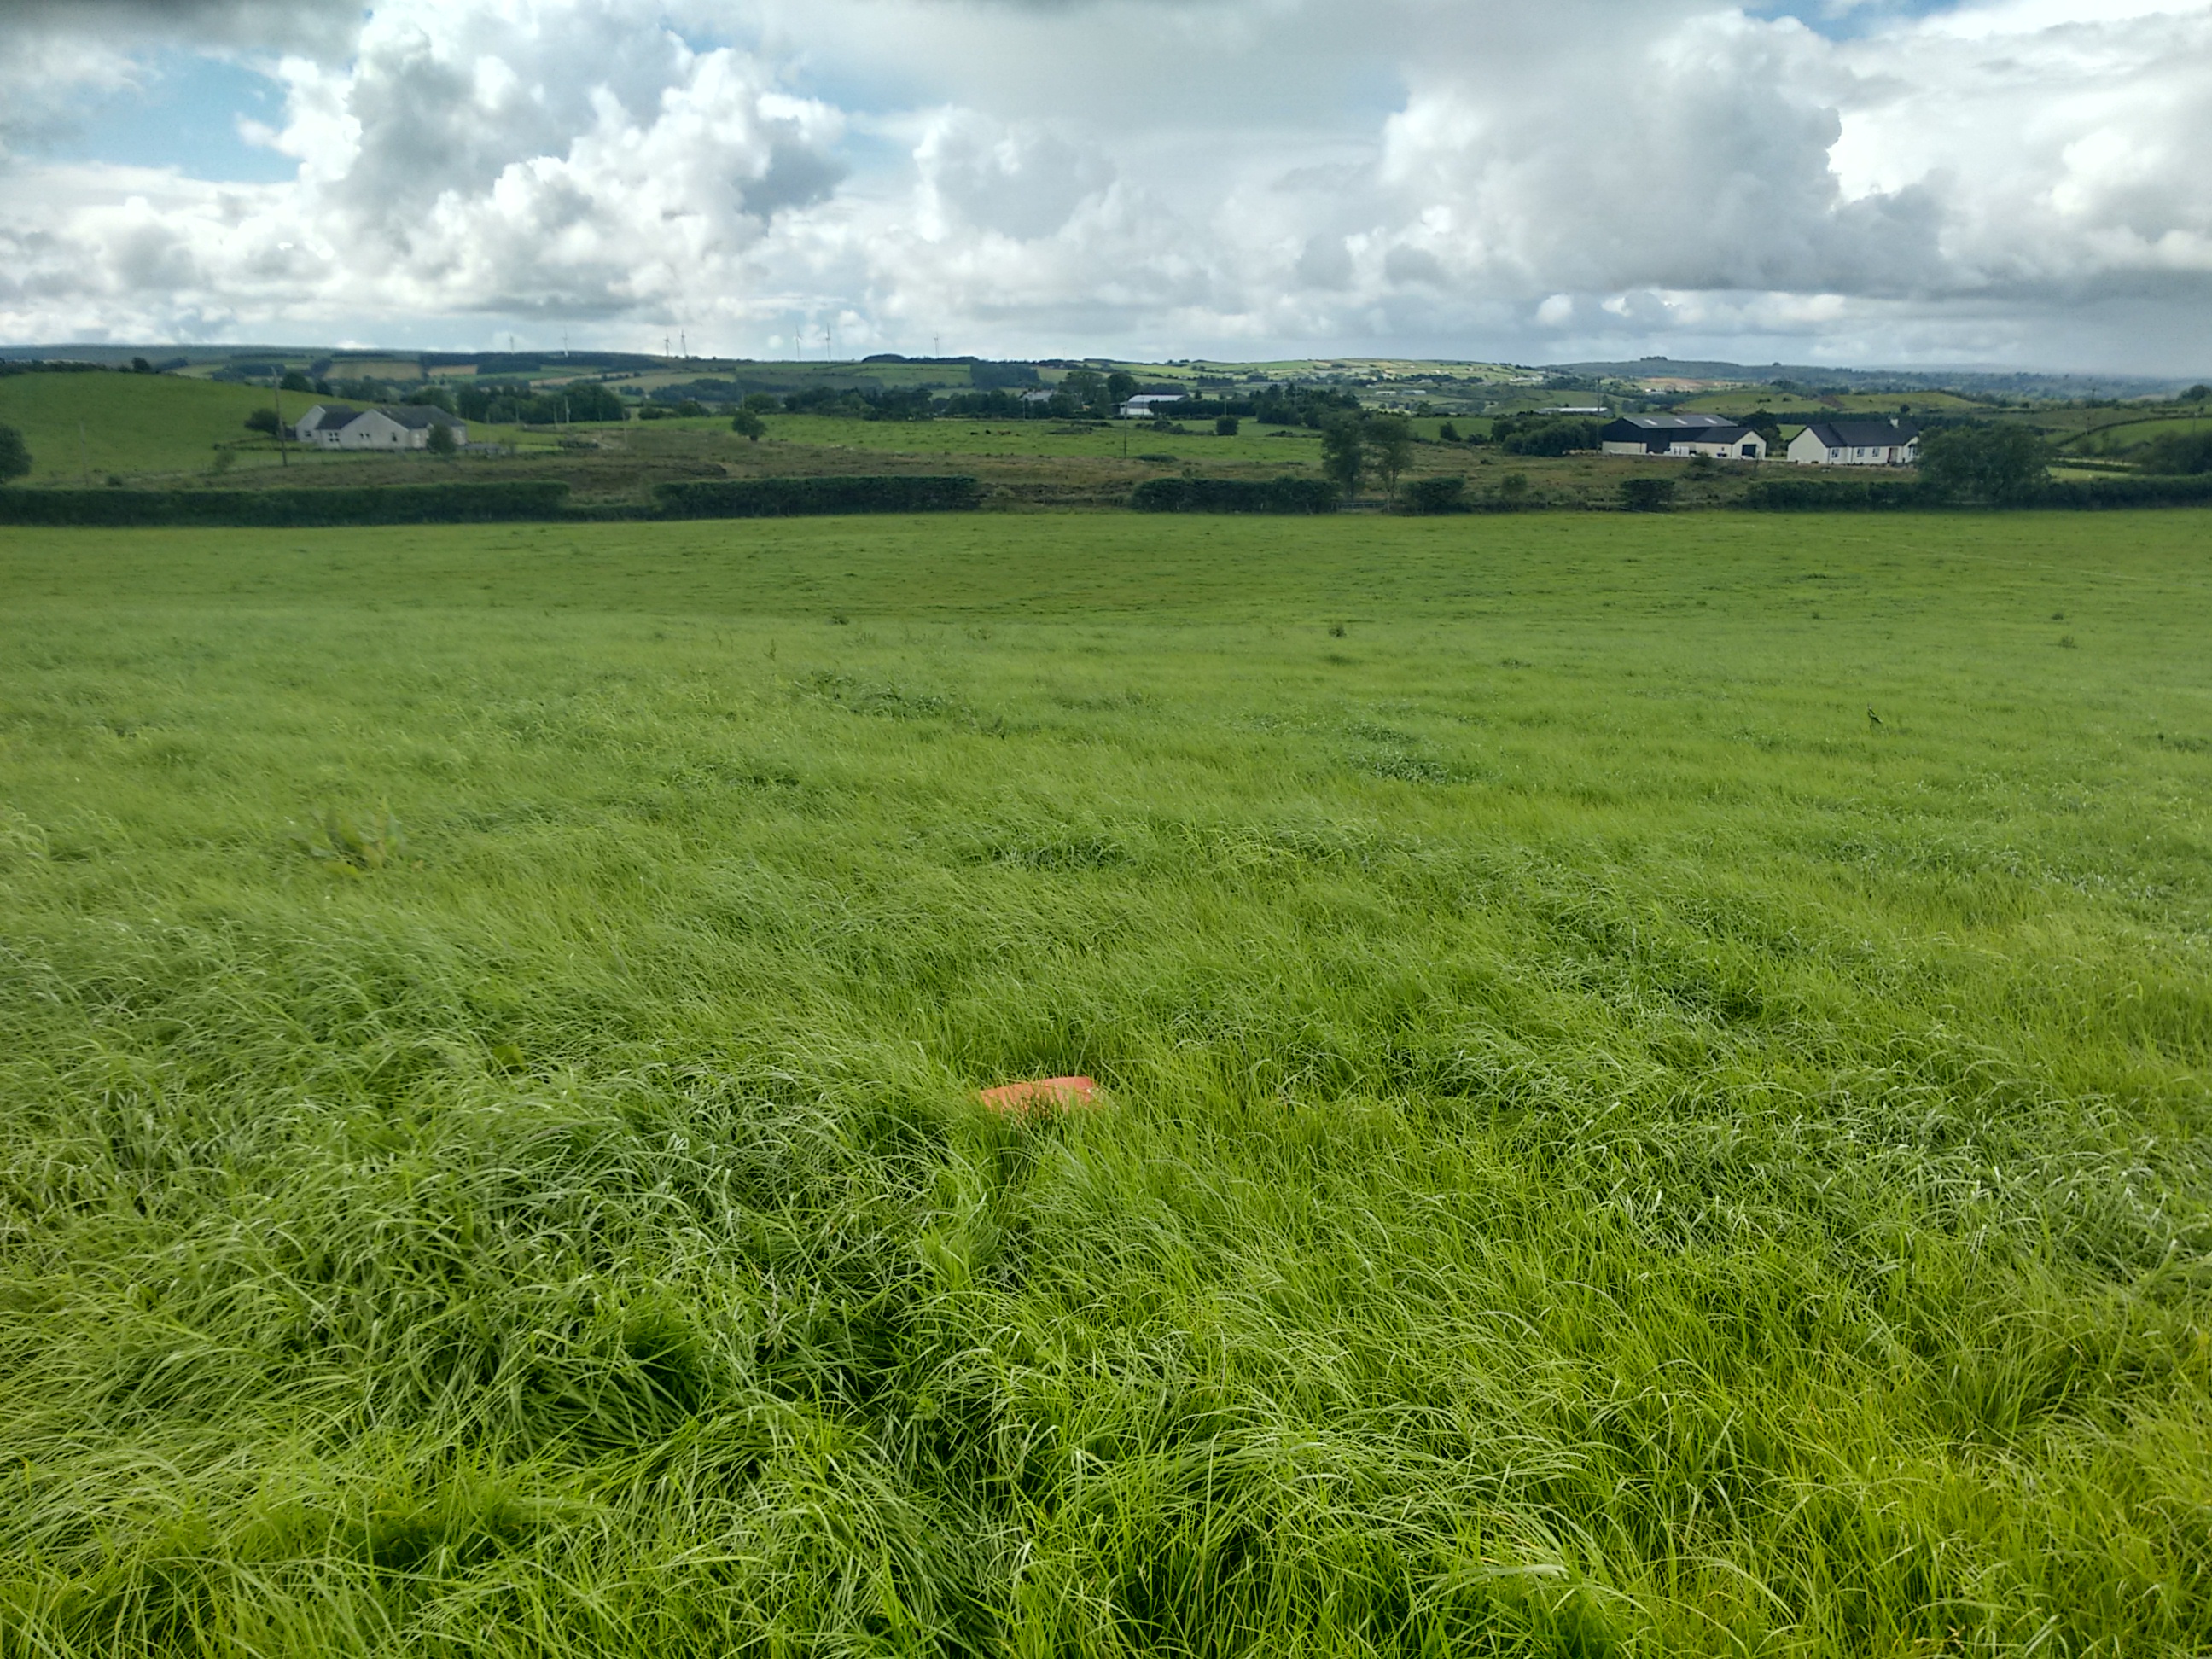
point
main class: Grassland
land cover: Grassland without tree/shrub cover
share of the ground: > 75 %
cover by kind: herbaceous plants 100 %
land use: Agriculture (excluding fallow land and kitchen gardens)
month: July
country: GB
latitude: 54.5989
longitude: -6.9956
